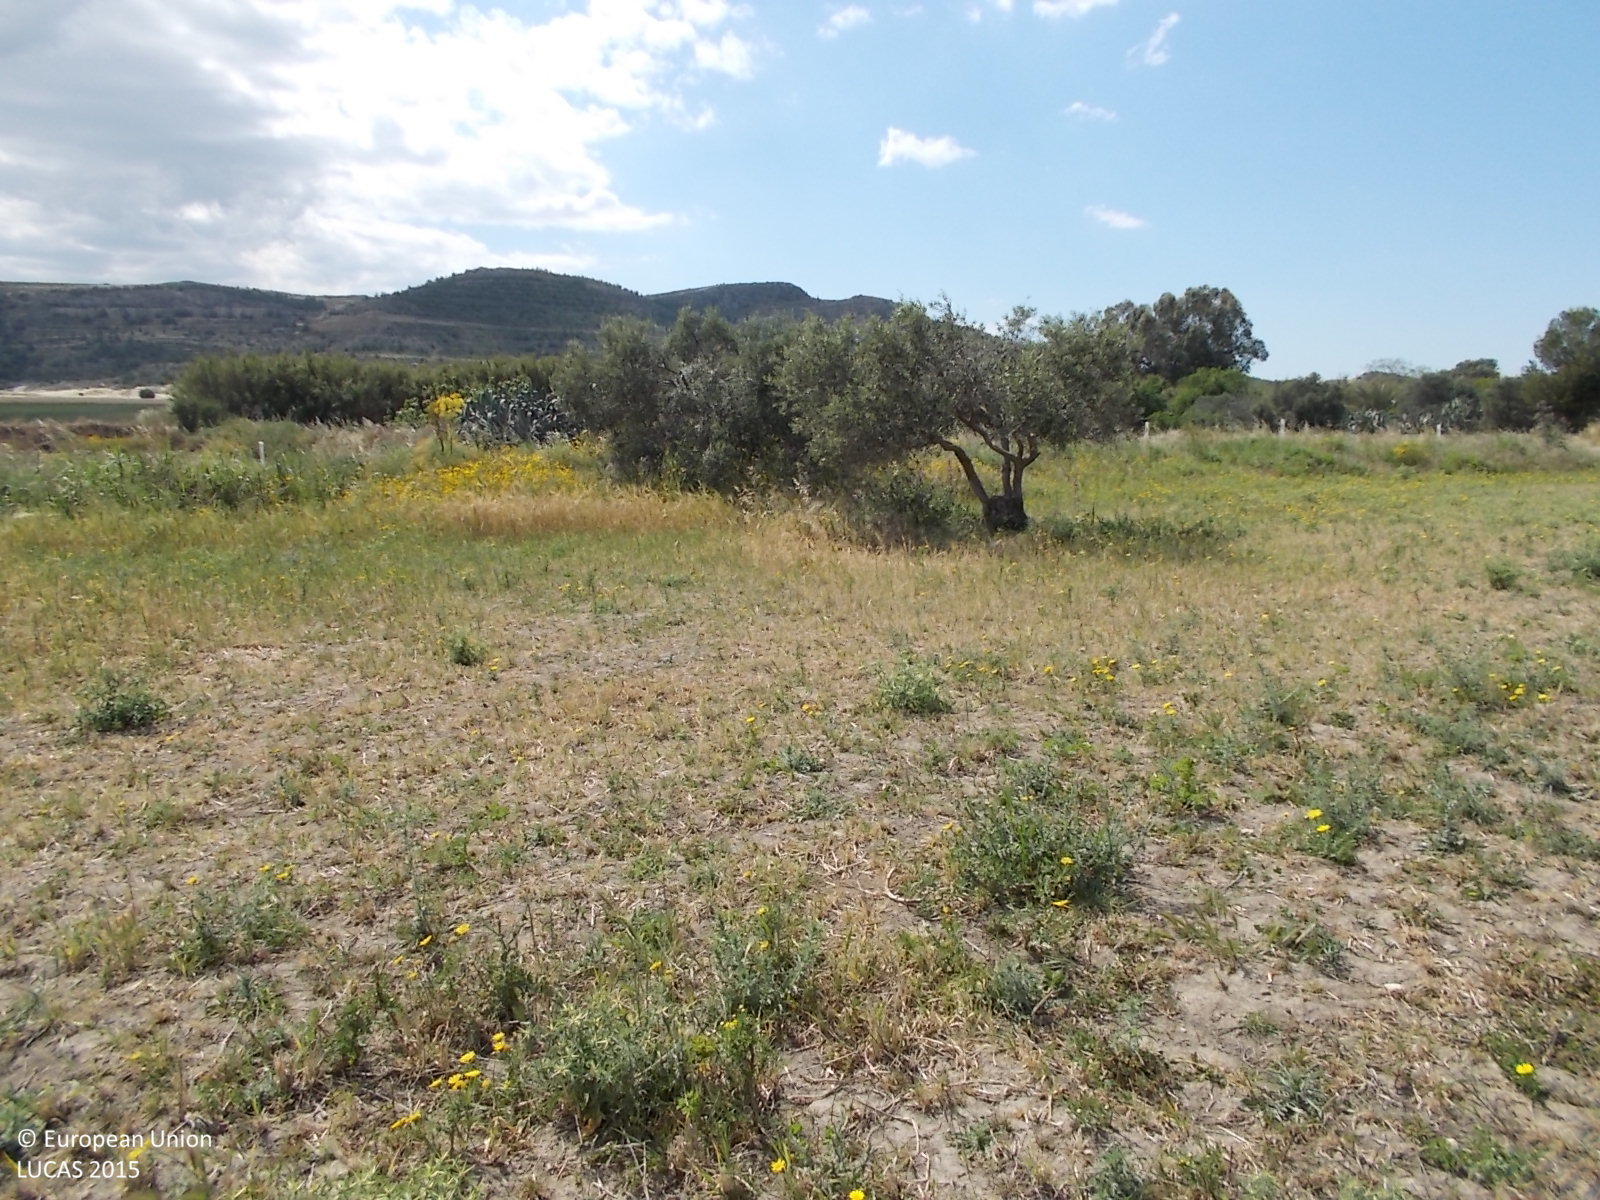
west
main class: Grassland
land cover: Grassland with sparse tree/shrub cover
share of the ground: 10 - 25 %
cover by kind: unconsolidated bare surface 80 %, herbaceous plants 15 %, broadleaved forest trees 5 %
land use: Agriculture (excluding fallow land and kitchen gardens)
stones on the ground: < 10 %
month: April
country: CY
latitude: 34.9986
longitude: 33.6585
